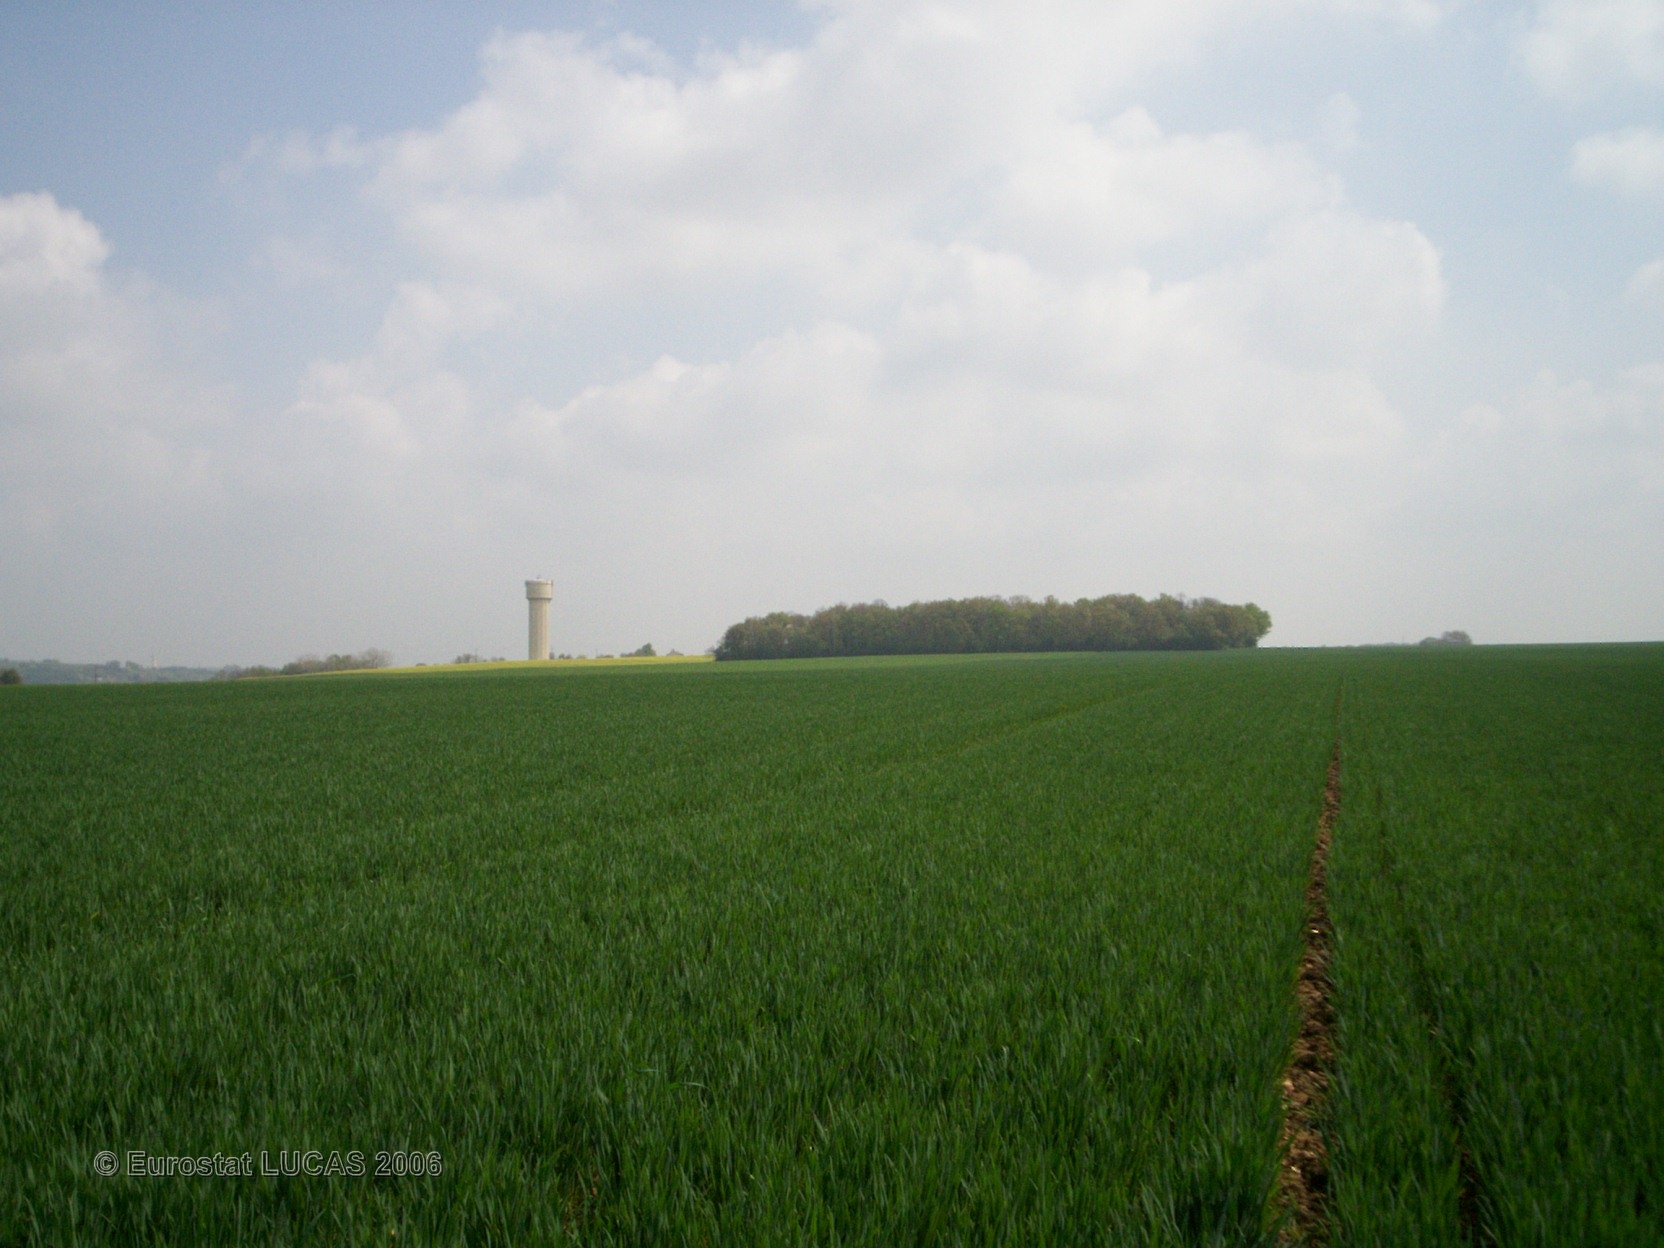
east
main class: Cropland
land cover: Common wheat
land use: Agriculture (excluding fallow land and kitchen gardens)
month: April
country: FR
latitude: 47.9214
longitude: 2.8866
